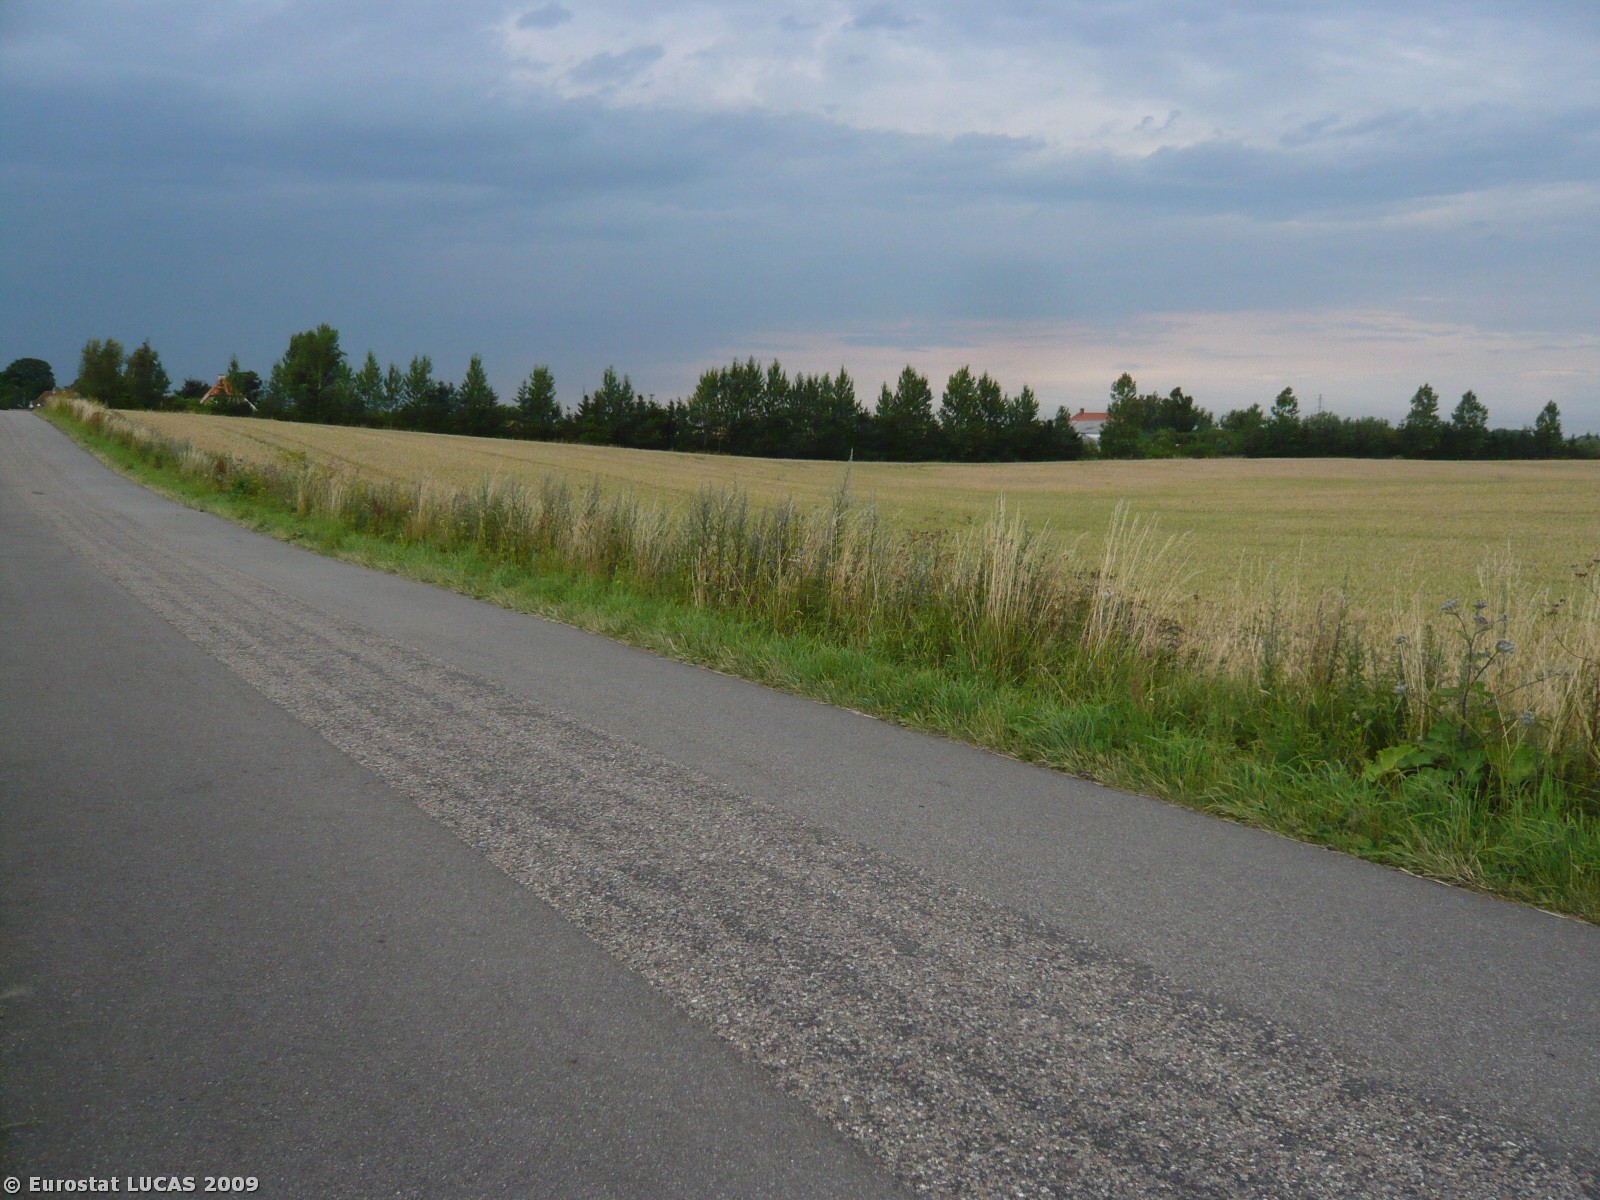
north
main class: Cropland
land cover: Common wheat
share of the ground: > 75 %
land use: Agriculture (excluding fallow land and kitchen gardens)
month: July
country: DK
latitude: 55.6945
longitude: 11.4146
